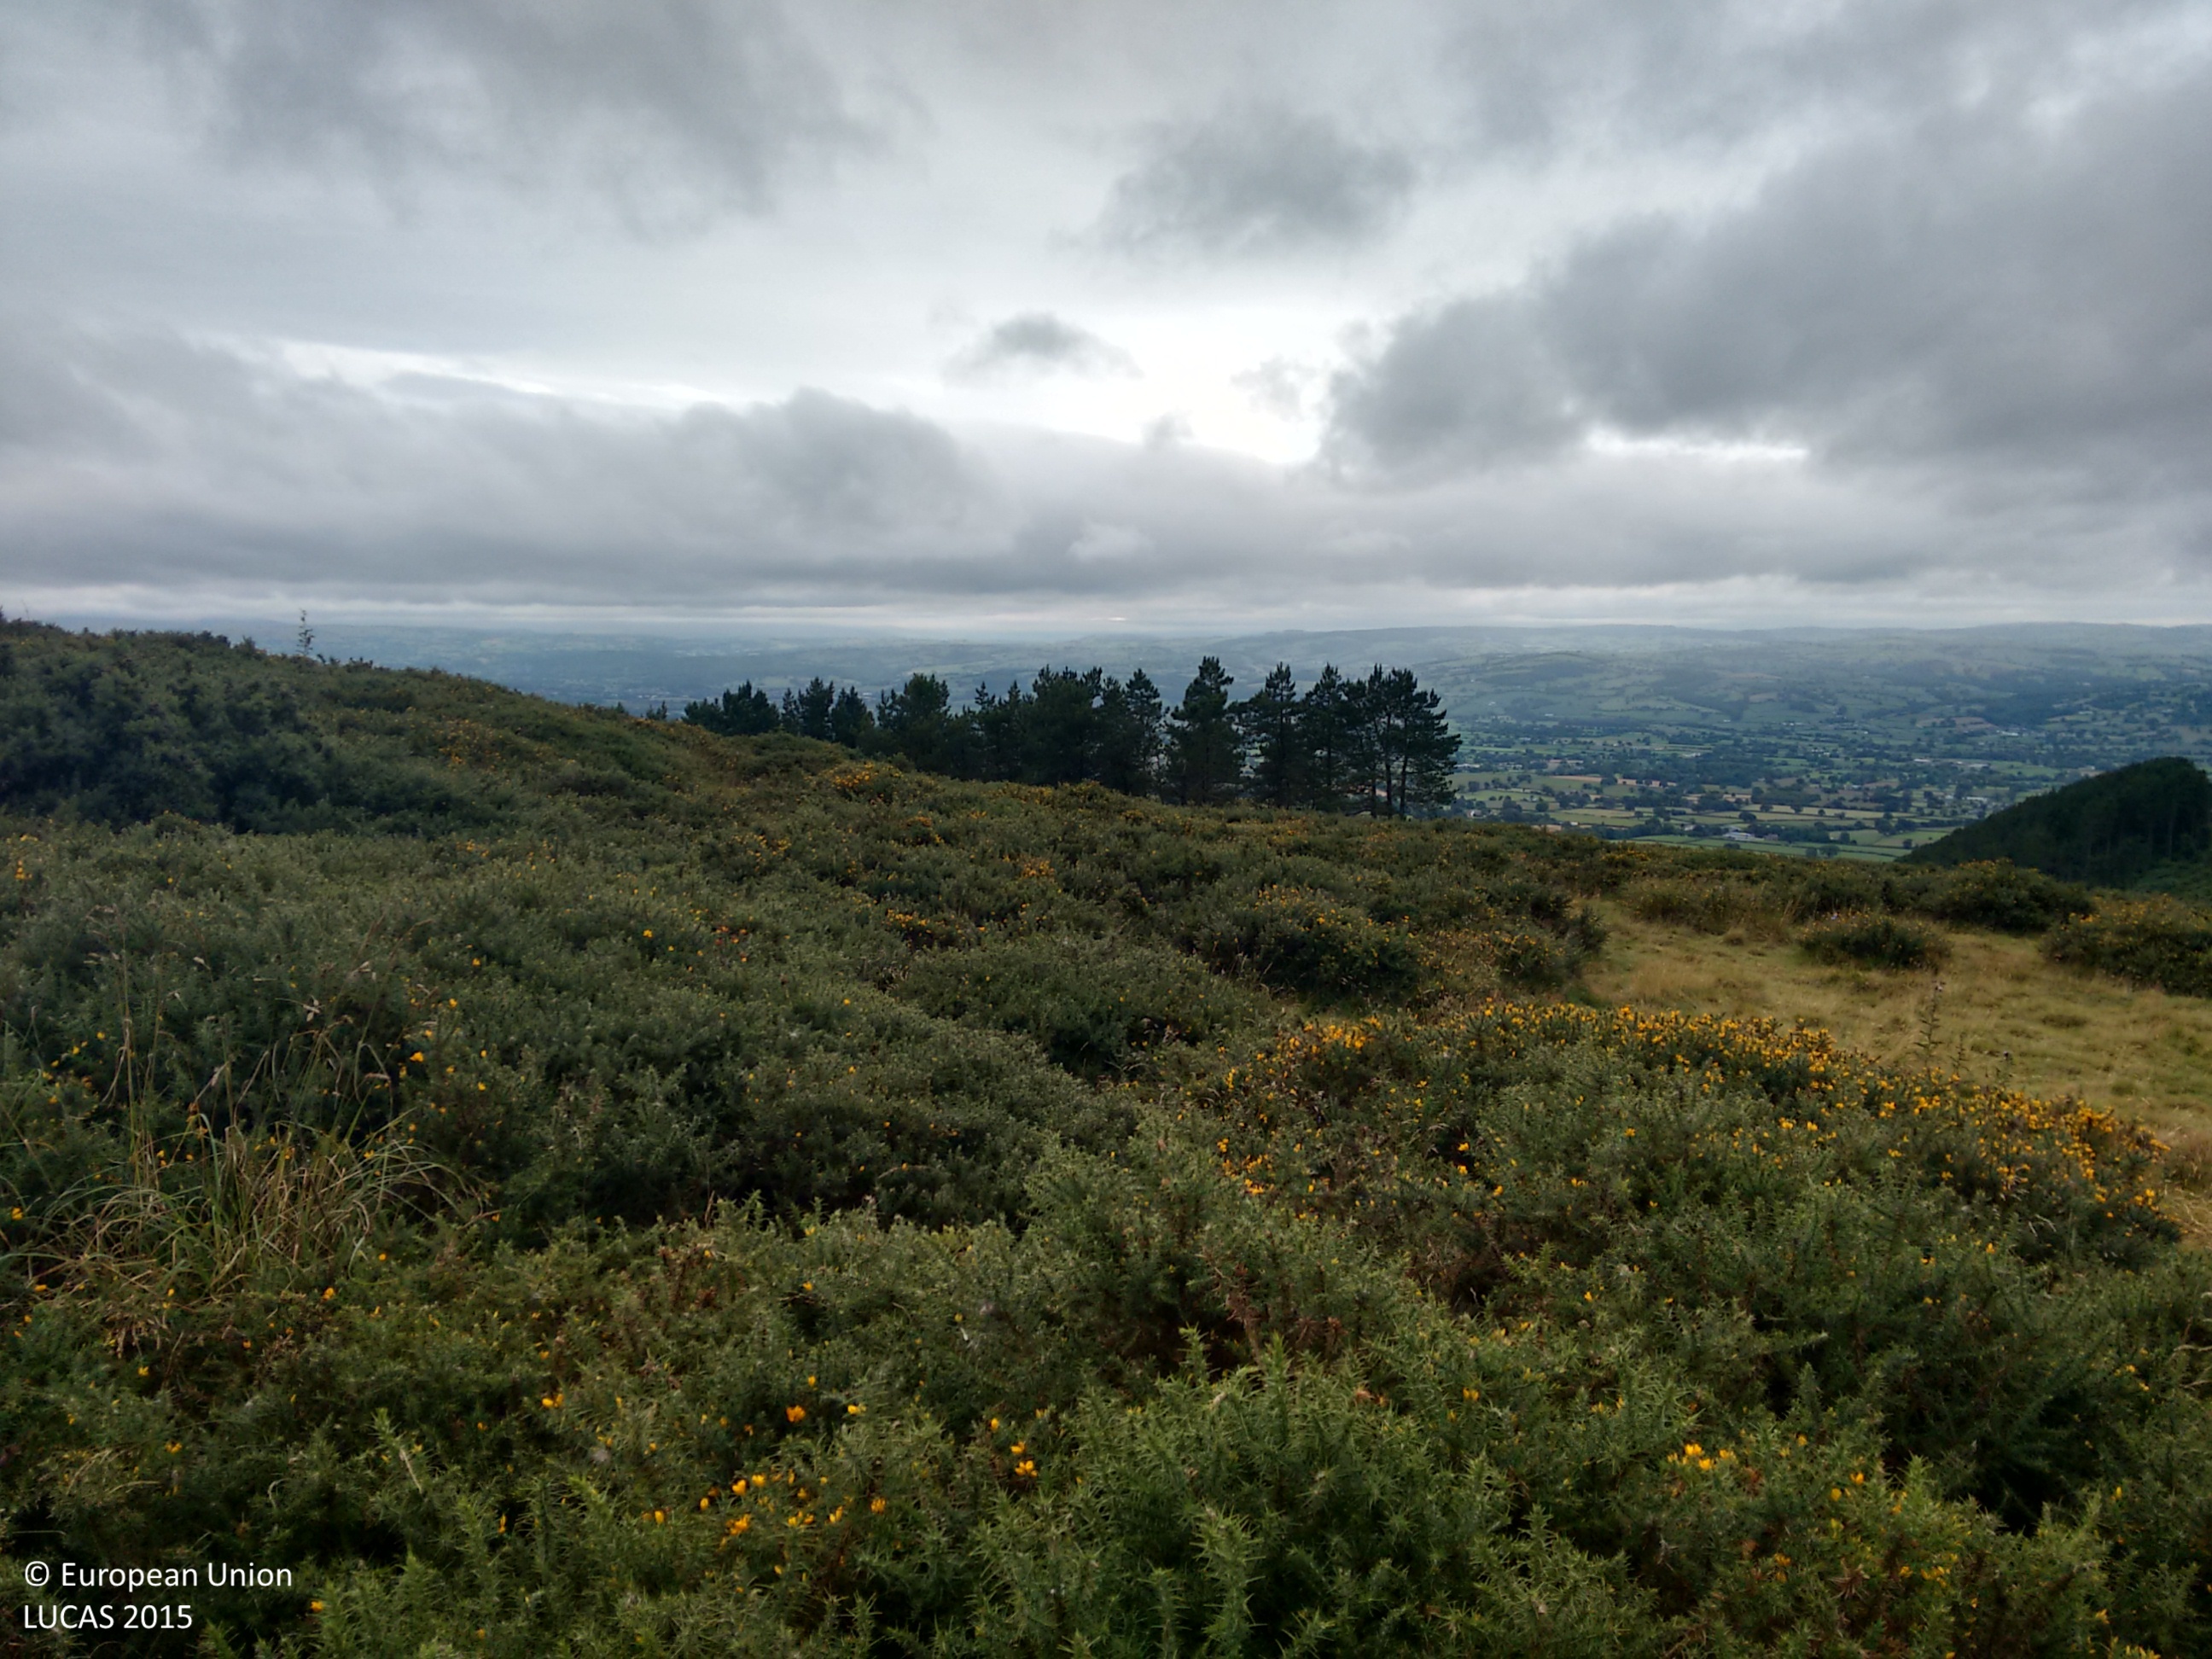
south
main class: Shrubland
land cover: Shrubland without tree cover
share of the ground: > 75 %
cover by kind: shrubs 100 %
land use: Agriculture (excluding fallow land and kitchen gardens)
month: August
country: GB
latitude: 53.1932
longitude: -3.2963
